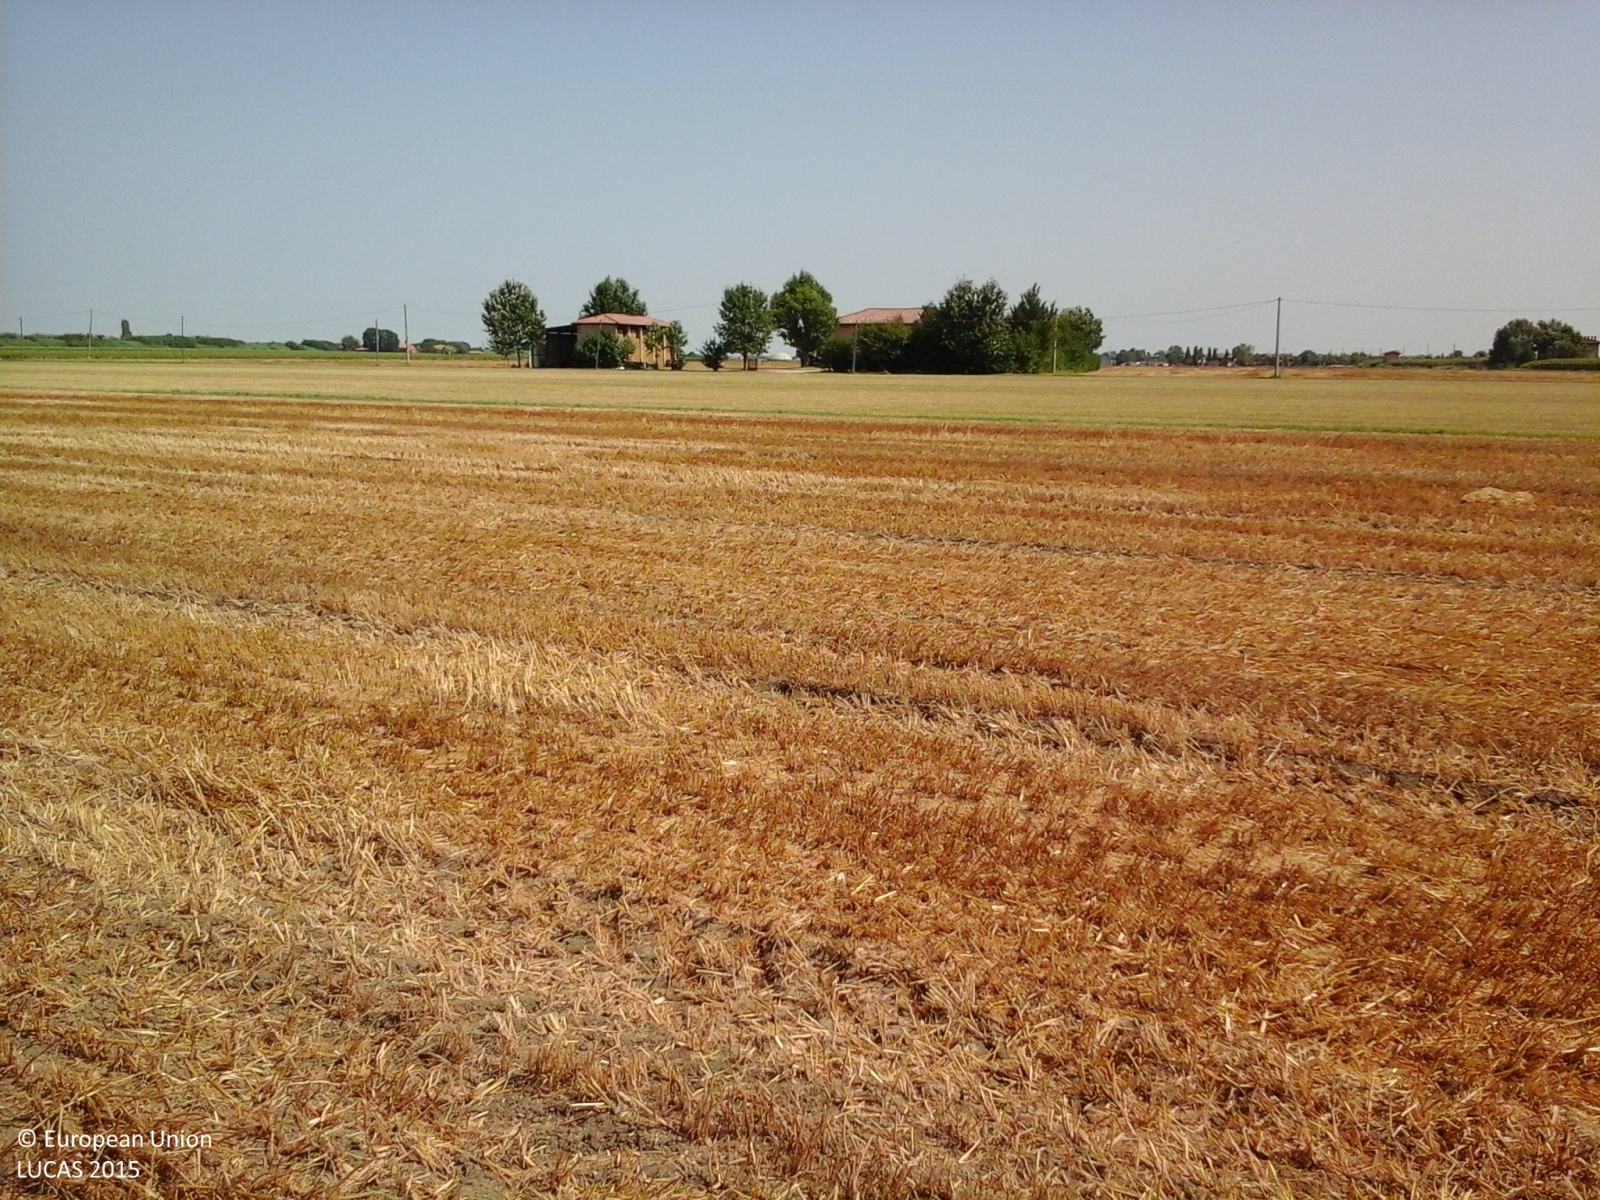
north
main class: Cropland
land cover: Common wheat
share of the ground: > 75 %
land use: Agriculture (excluding fallow land and kitchen gardens)
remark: Harvested field
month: July
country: IT
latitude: 44.5183
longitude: 11.6195
